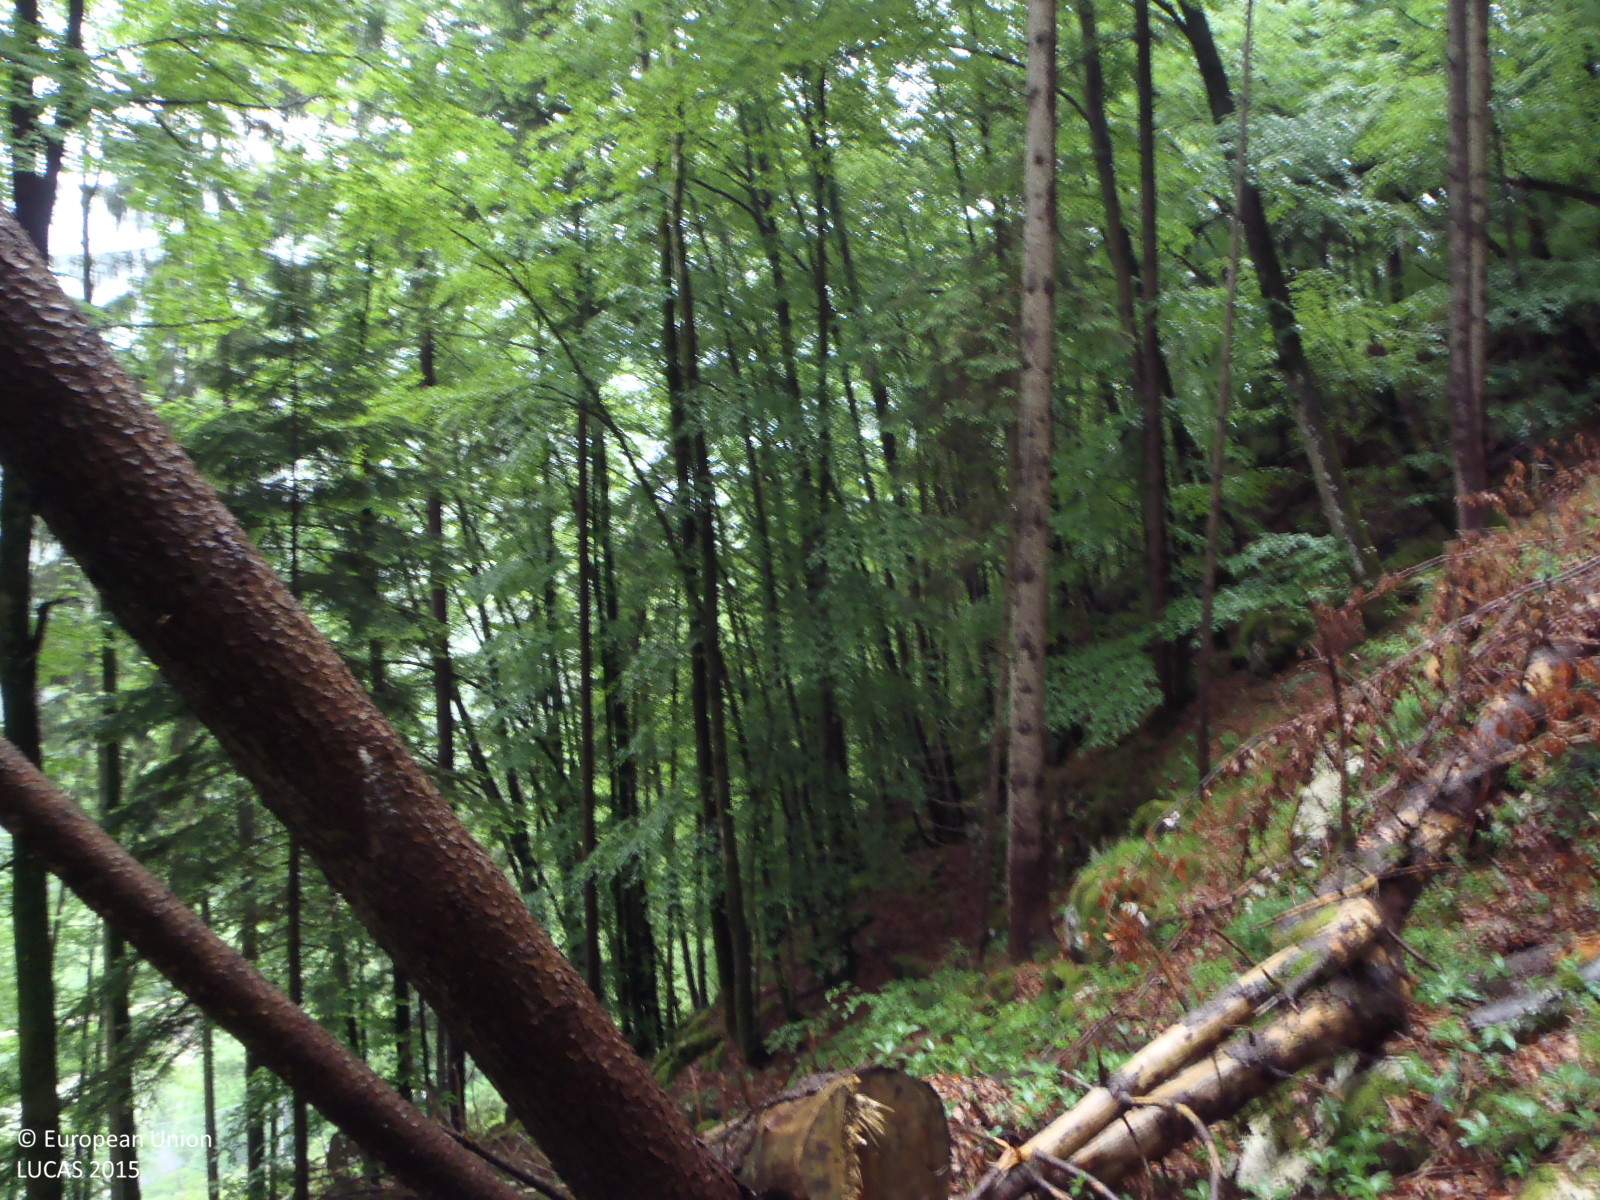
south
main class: Woodland
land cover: Other mixed woodland
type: mountainous beech forest
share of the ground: > 75 %
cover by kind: broadleaved forest trees 60 %, coniferous forest trees 30 %, herbaceous plants 5 %, lichens and mosses 5 %
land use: Forestry
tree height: > 5 m
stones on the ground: < 10 %
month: May
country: AT
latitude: 47.6316
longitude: 12.7266
